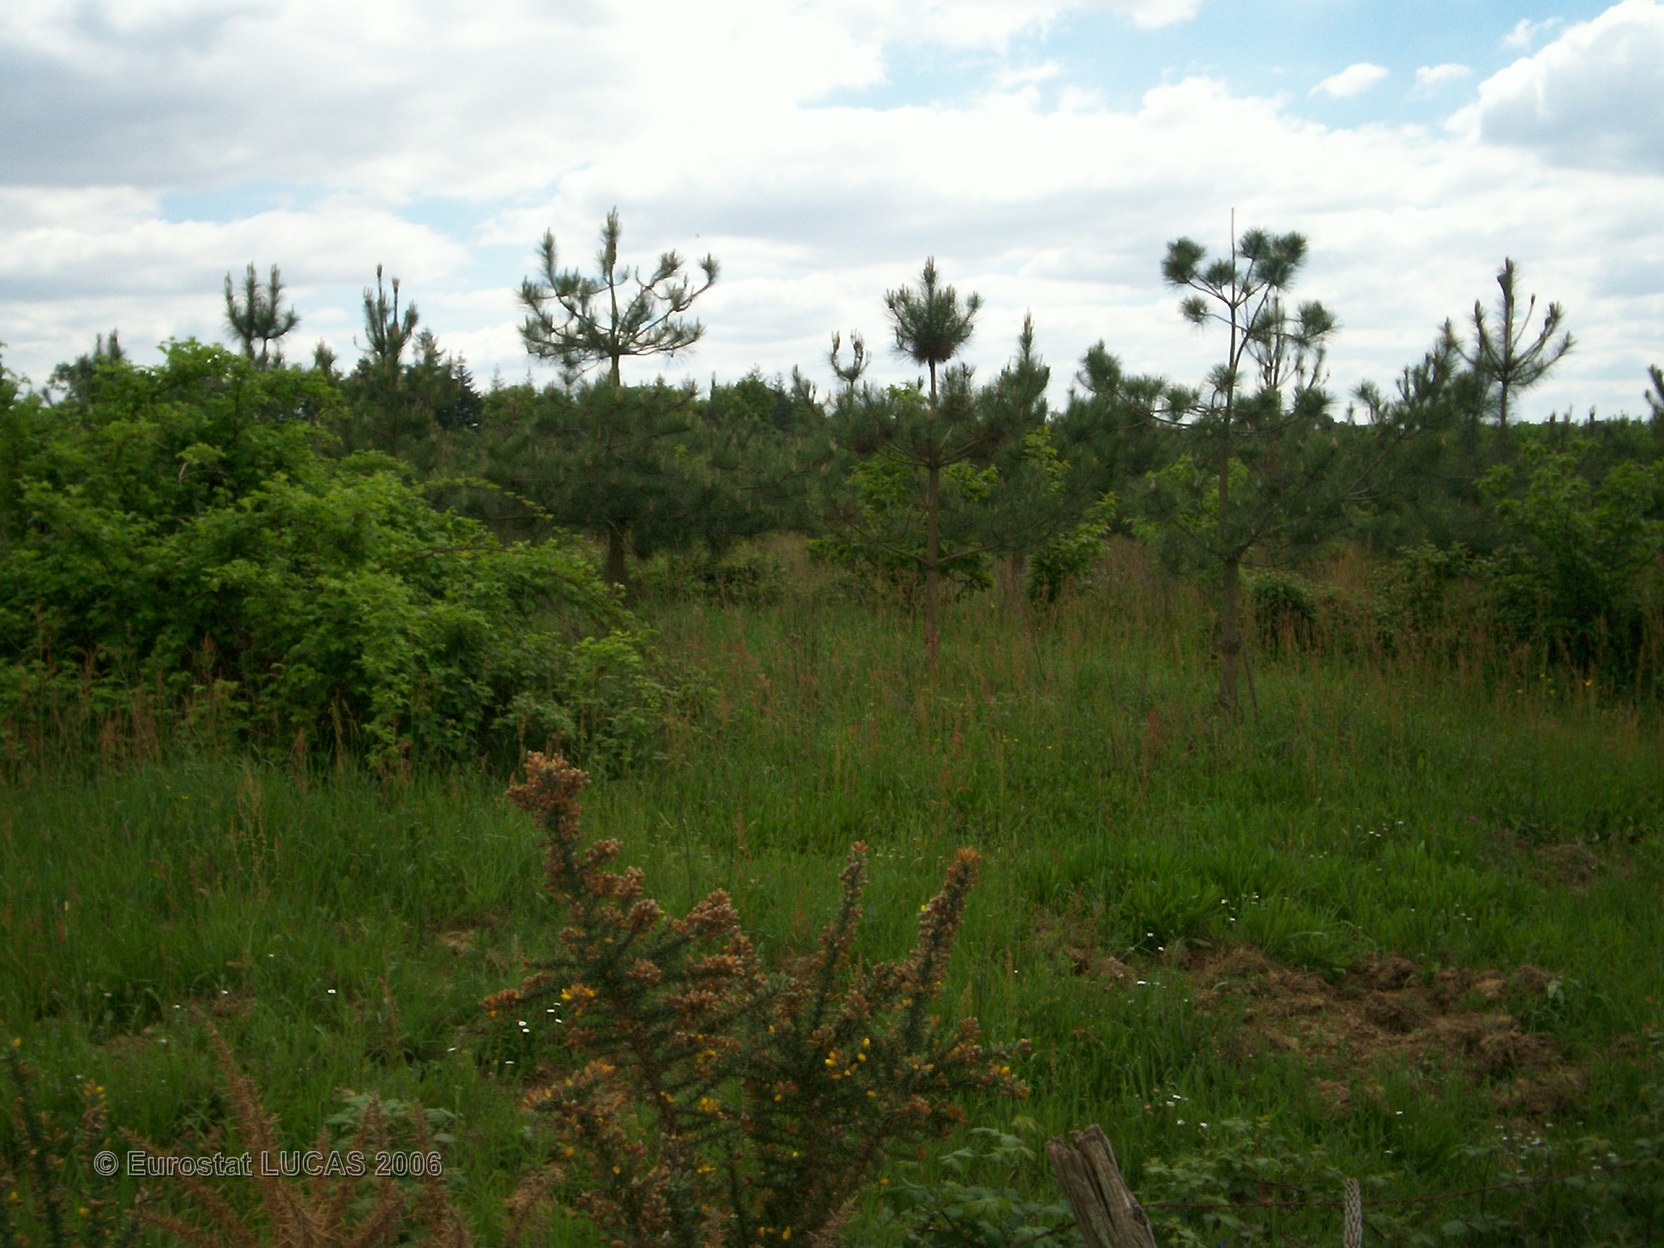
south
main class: Artificial land
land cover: Non built-up linear features
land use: Road transport
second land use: Agriculture (excluding fallow land and kitchen gardens)
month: May
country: FR
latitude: 46.6341
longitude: -1.0182
